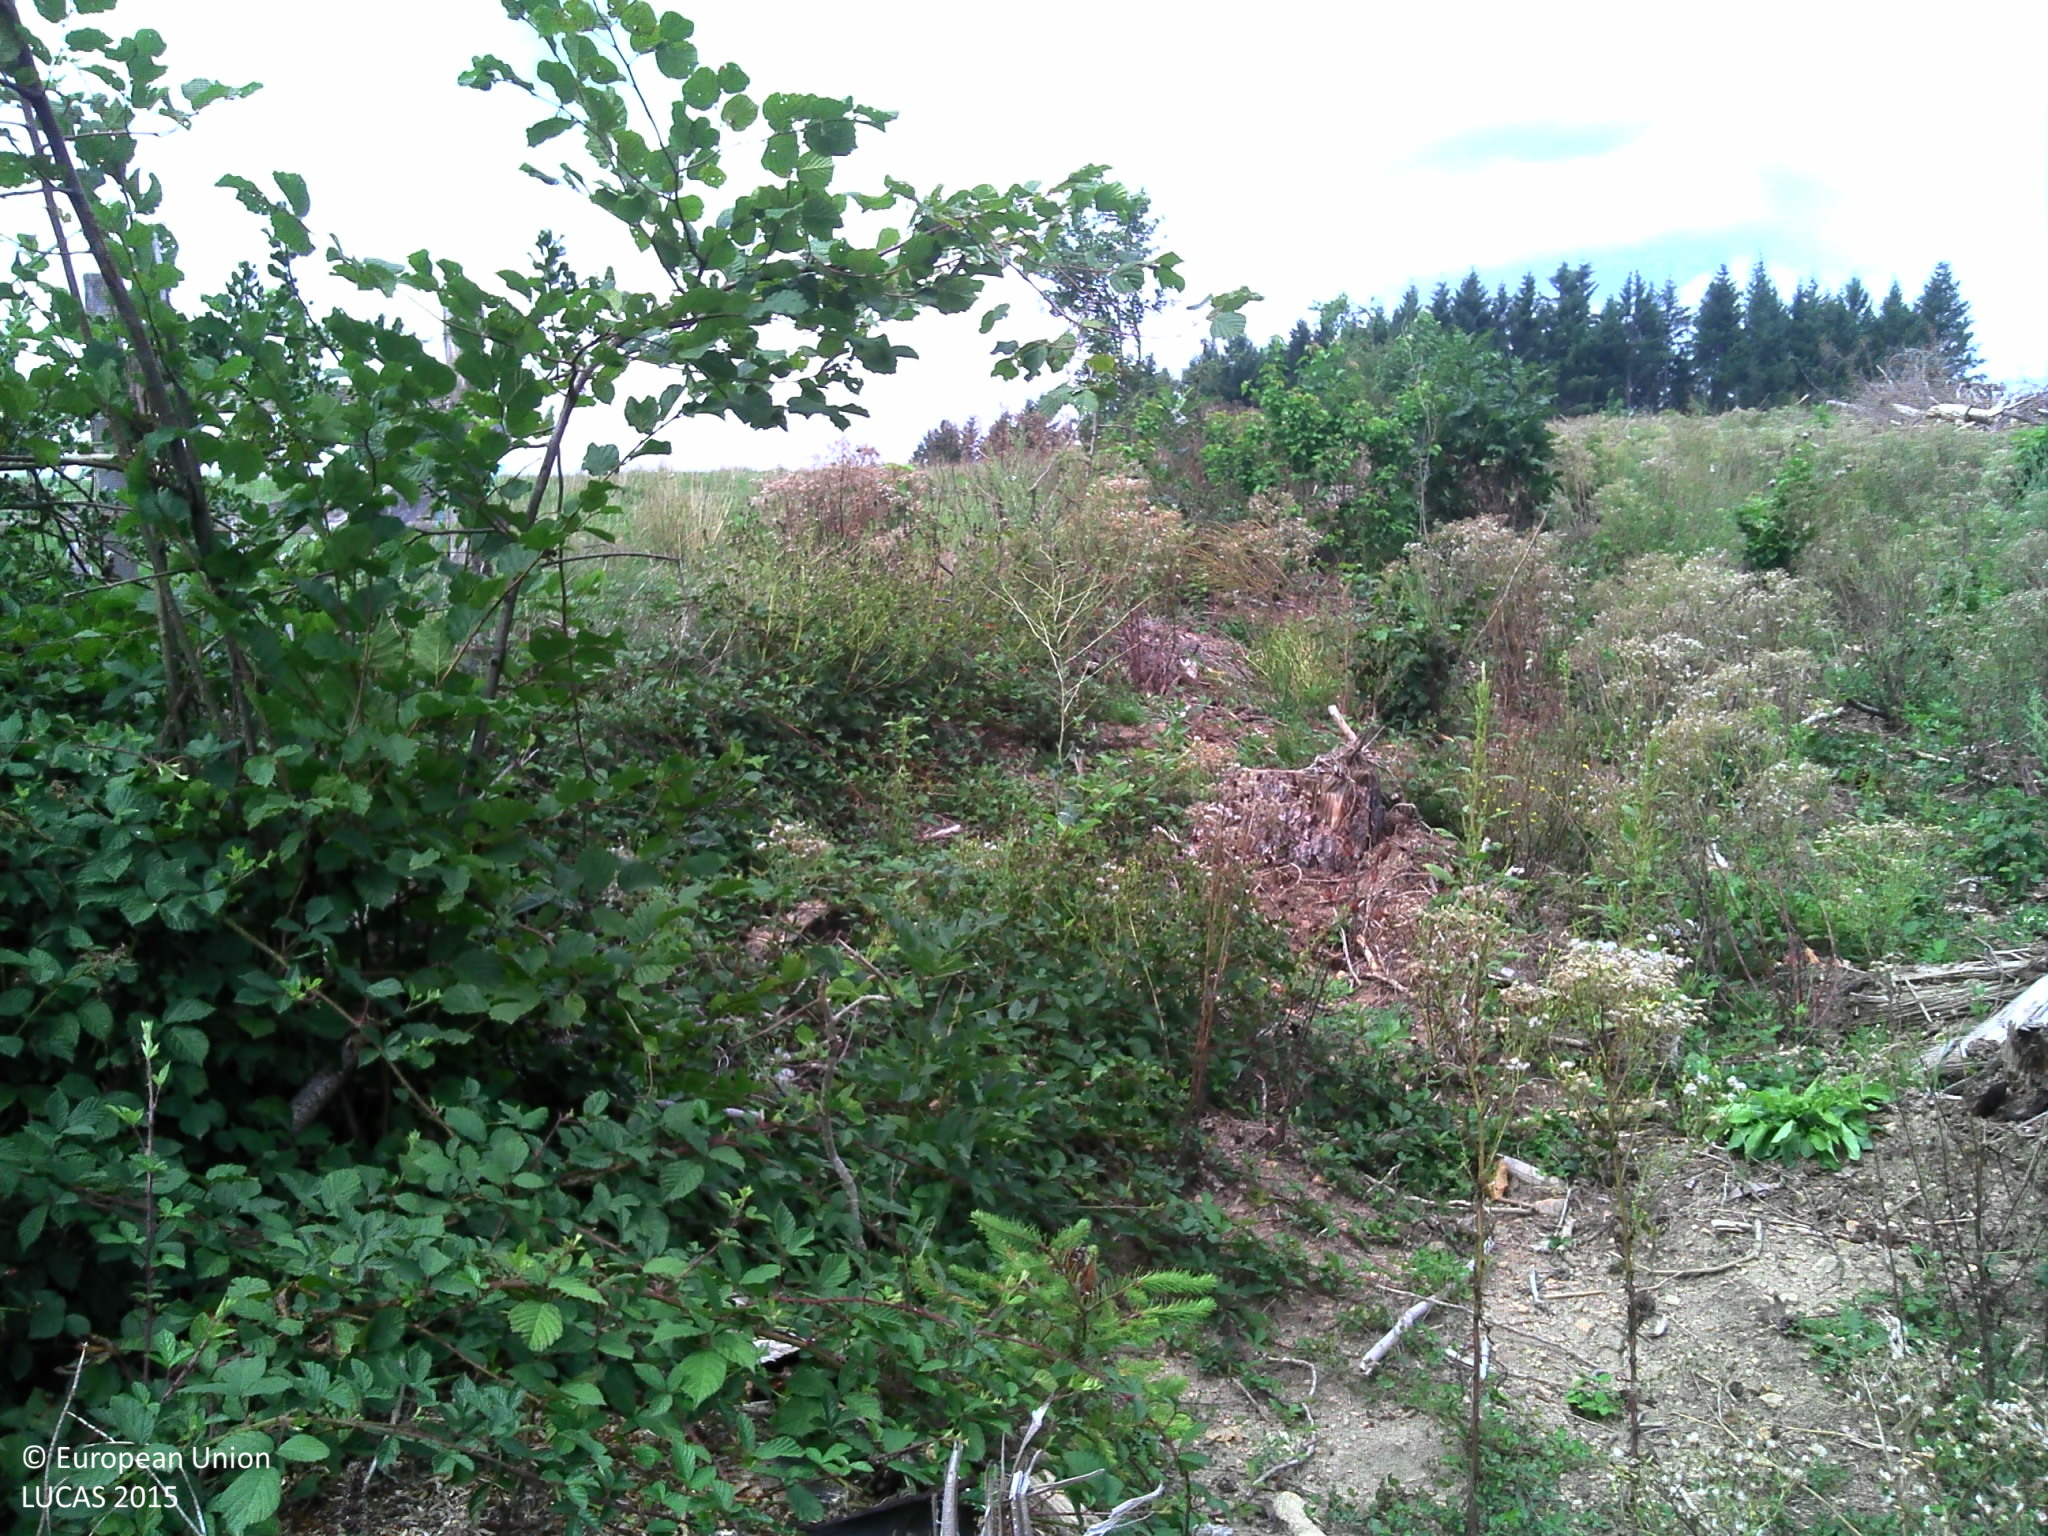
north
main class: Shrubland
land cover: Shrubland without tree cover
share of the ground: > 75 %
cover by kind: shrubs 60 %, herbaceous plants 30 %, consolidated bare surface 10 %
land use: Forestry
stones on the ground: 25 - 50 %
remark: Clear cut
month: August
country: FR
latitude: 46.2413
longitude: 4.4122
